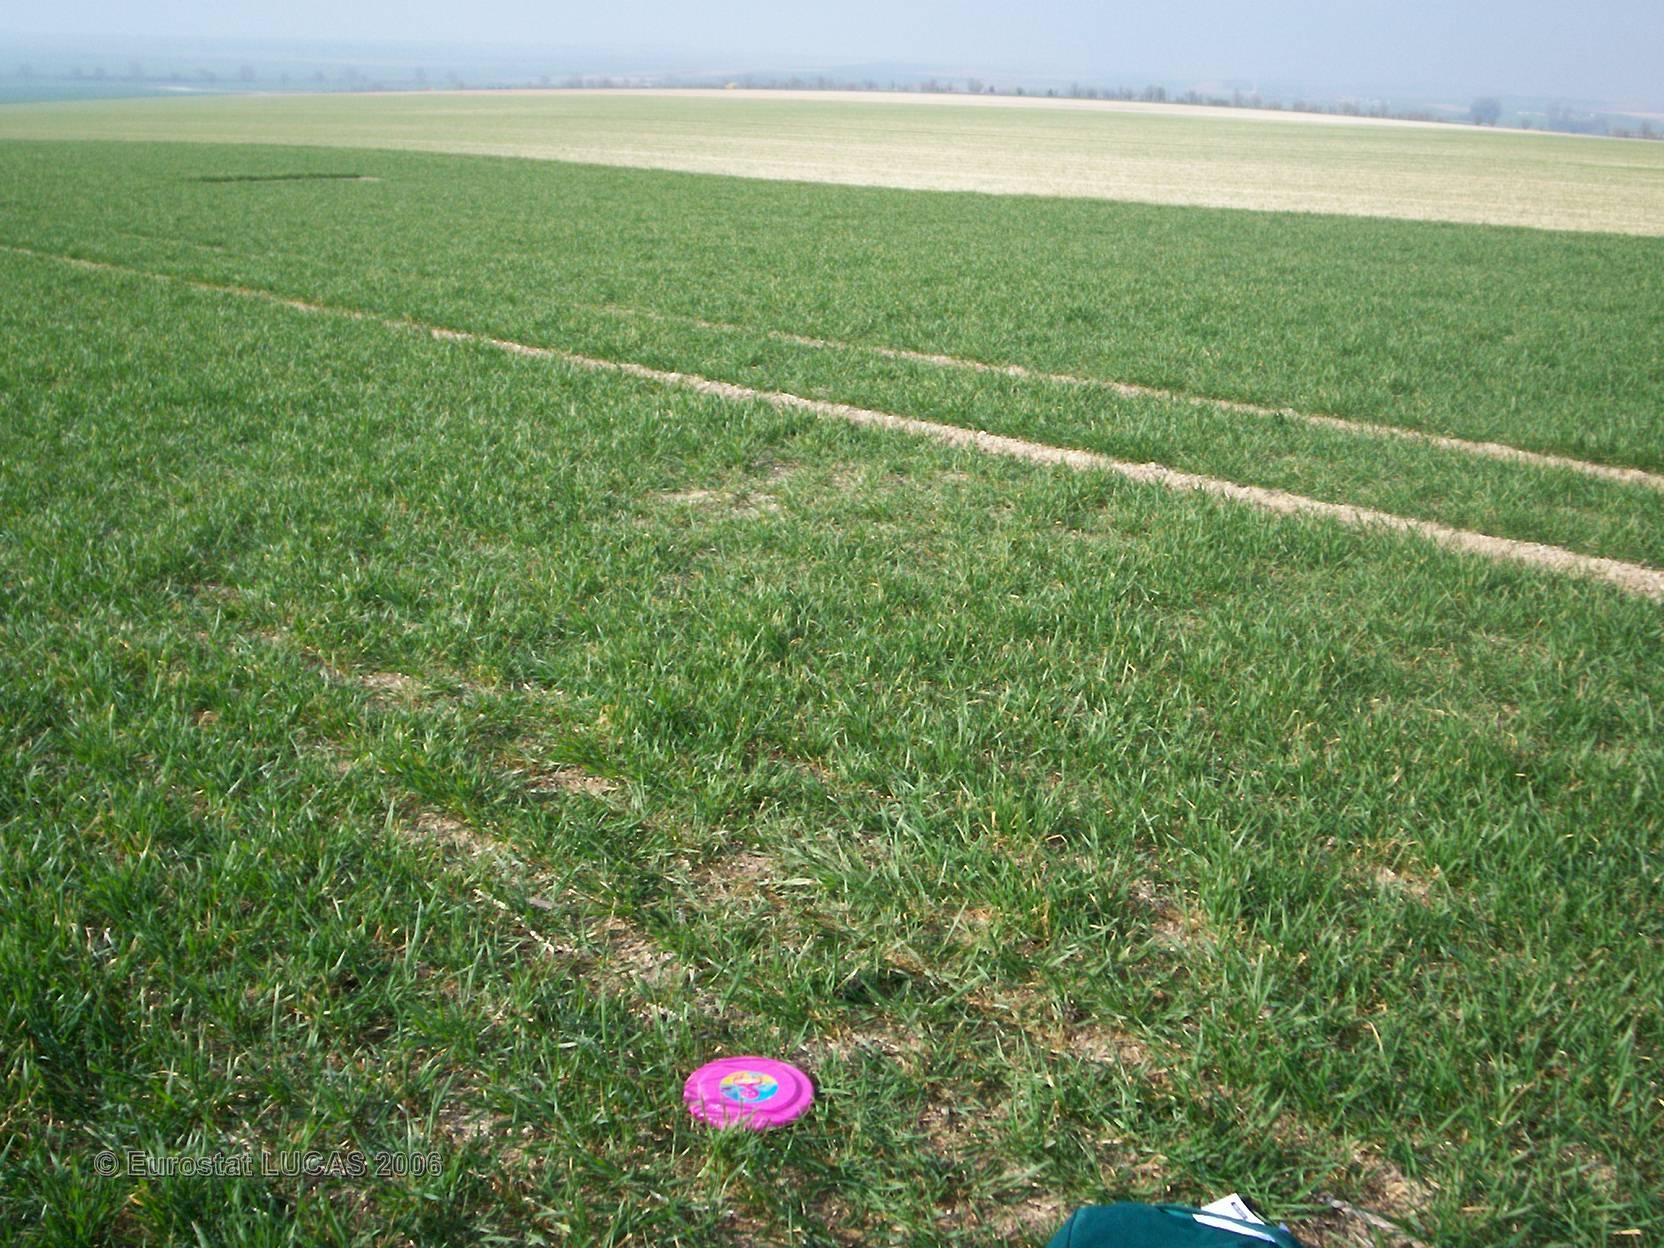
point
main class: Cropland
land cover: Barley
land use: Agriculture (excluding fallow land and kitchen gardens)
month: April
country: FR
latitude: 49.1196
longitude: 4.6121
